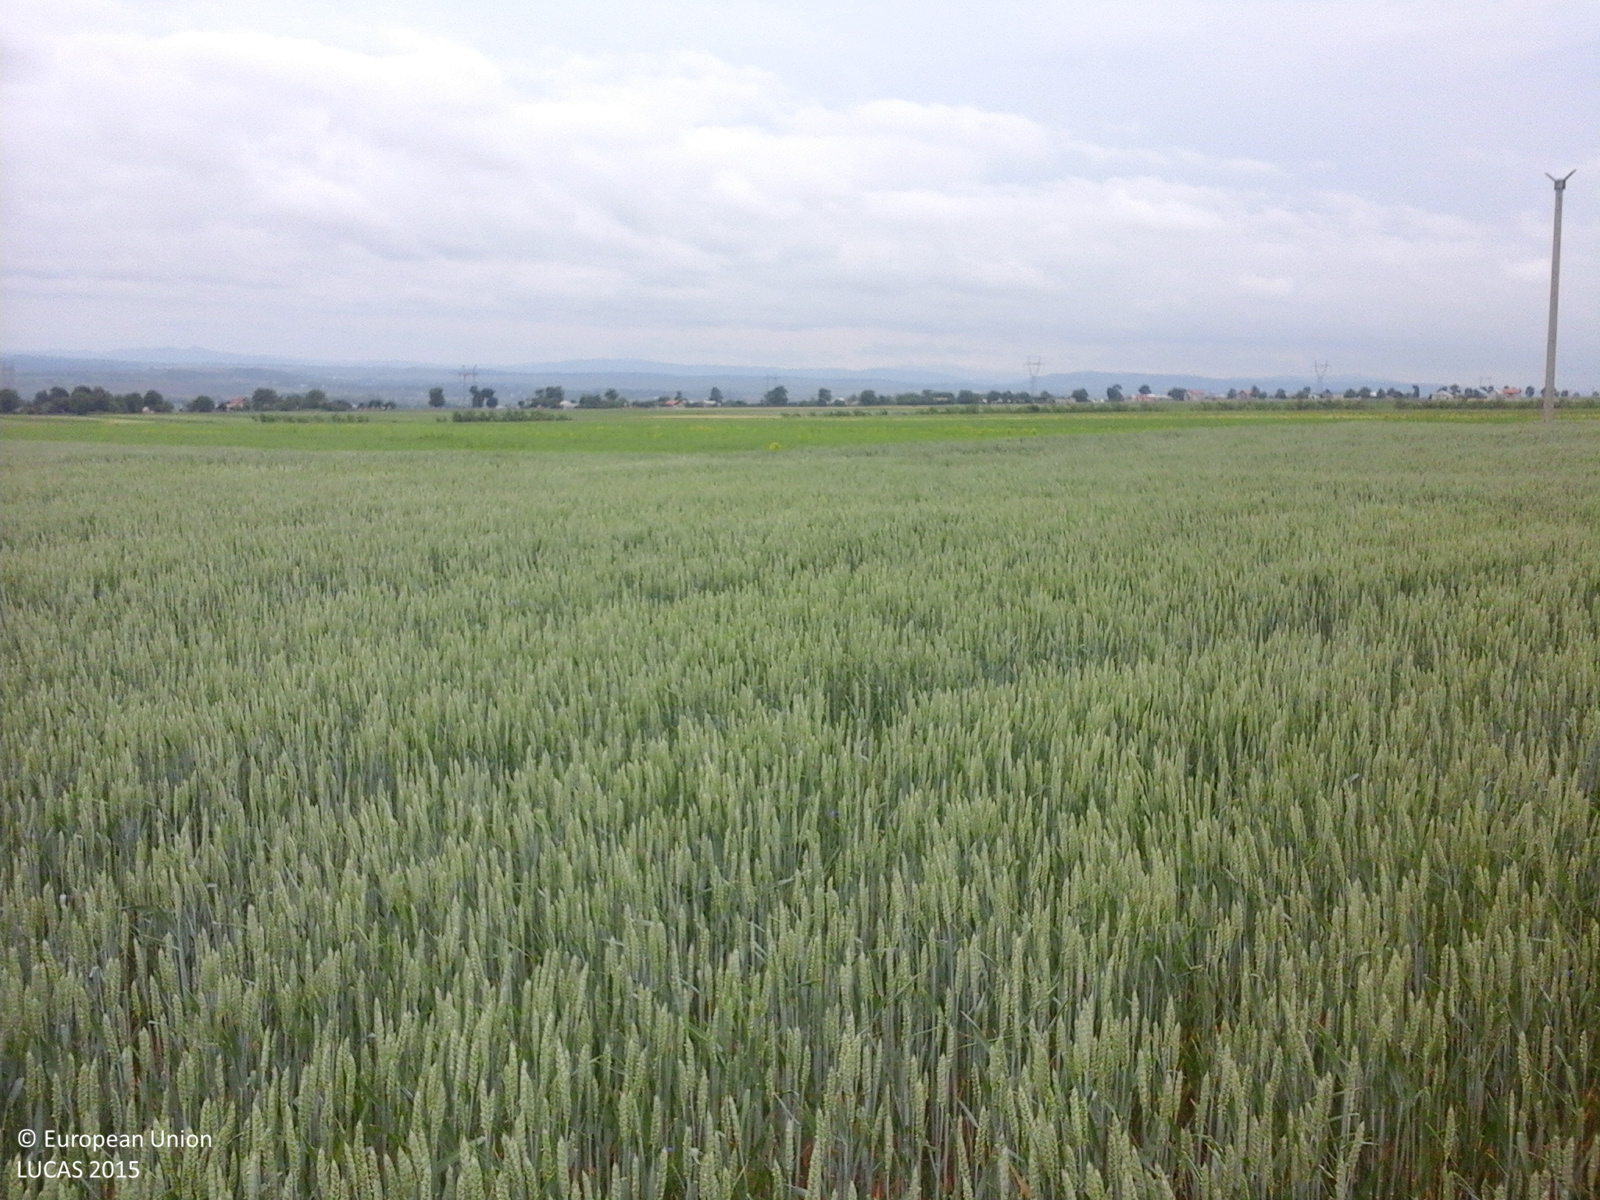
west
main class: Cropland
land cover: Common wheat
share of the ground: > 75 %
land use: Agriculture (excluding fallow land and kitchen gardens)
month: June
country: RO
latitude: 47.1233
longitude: 26.6870
